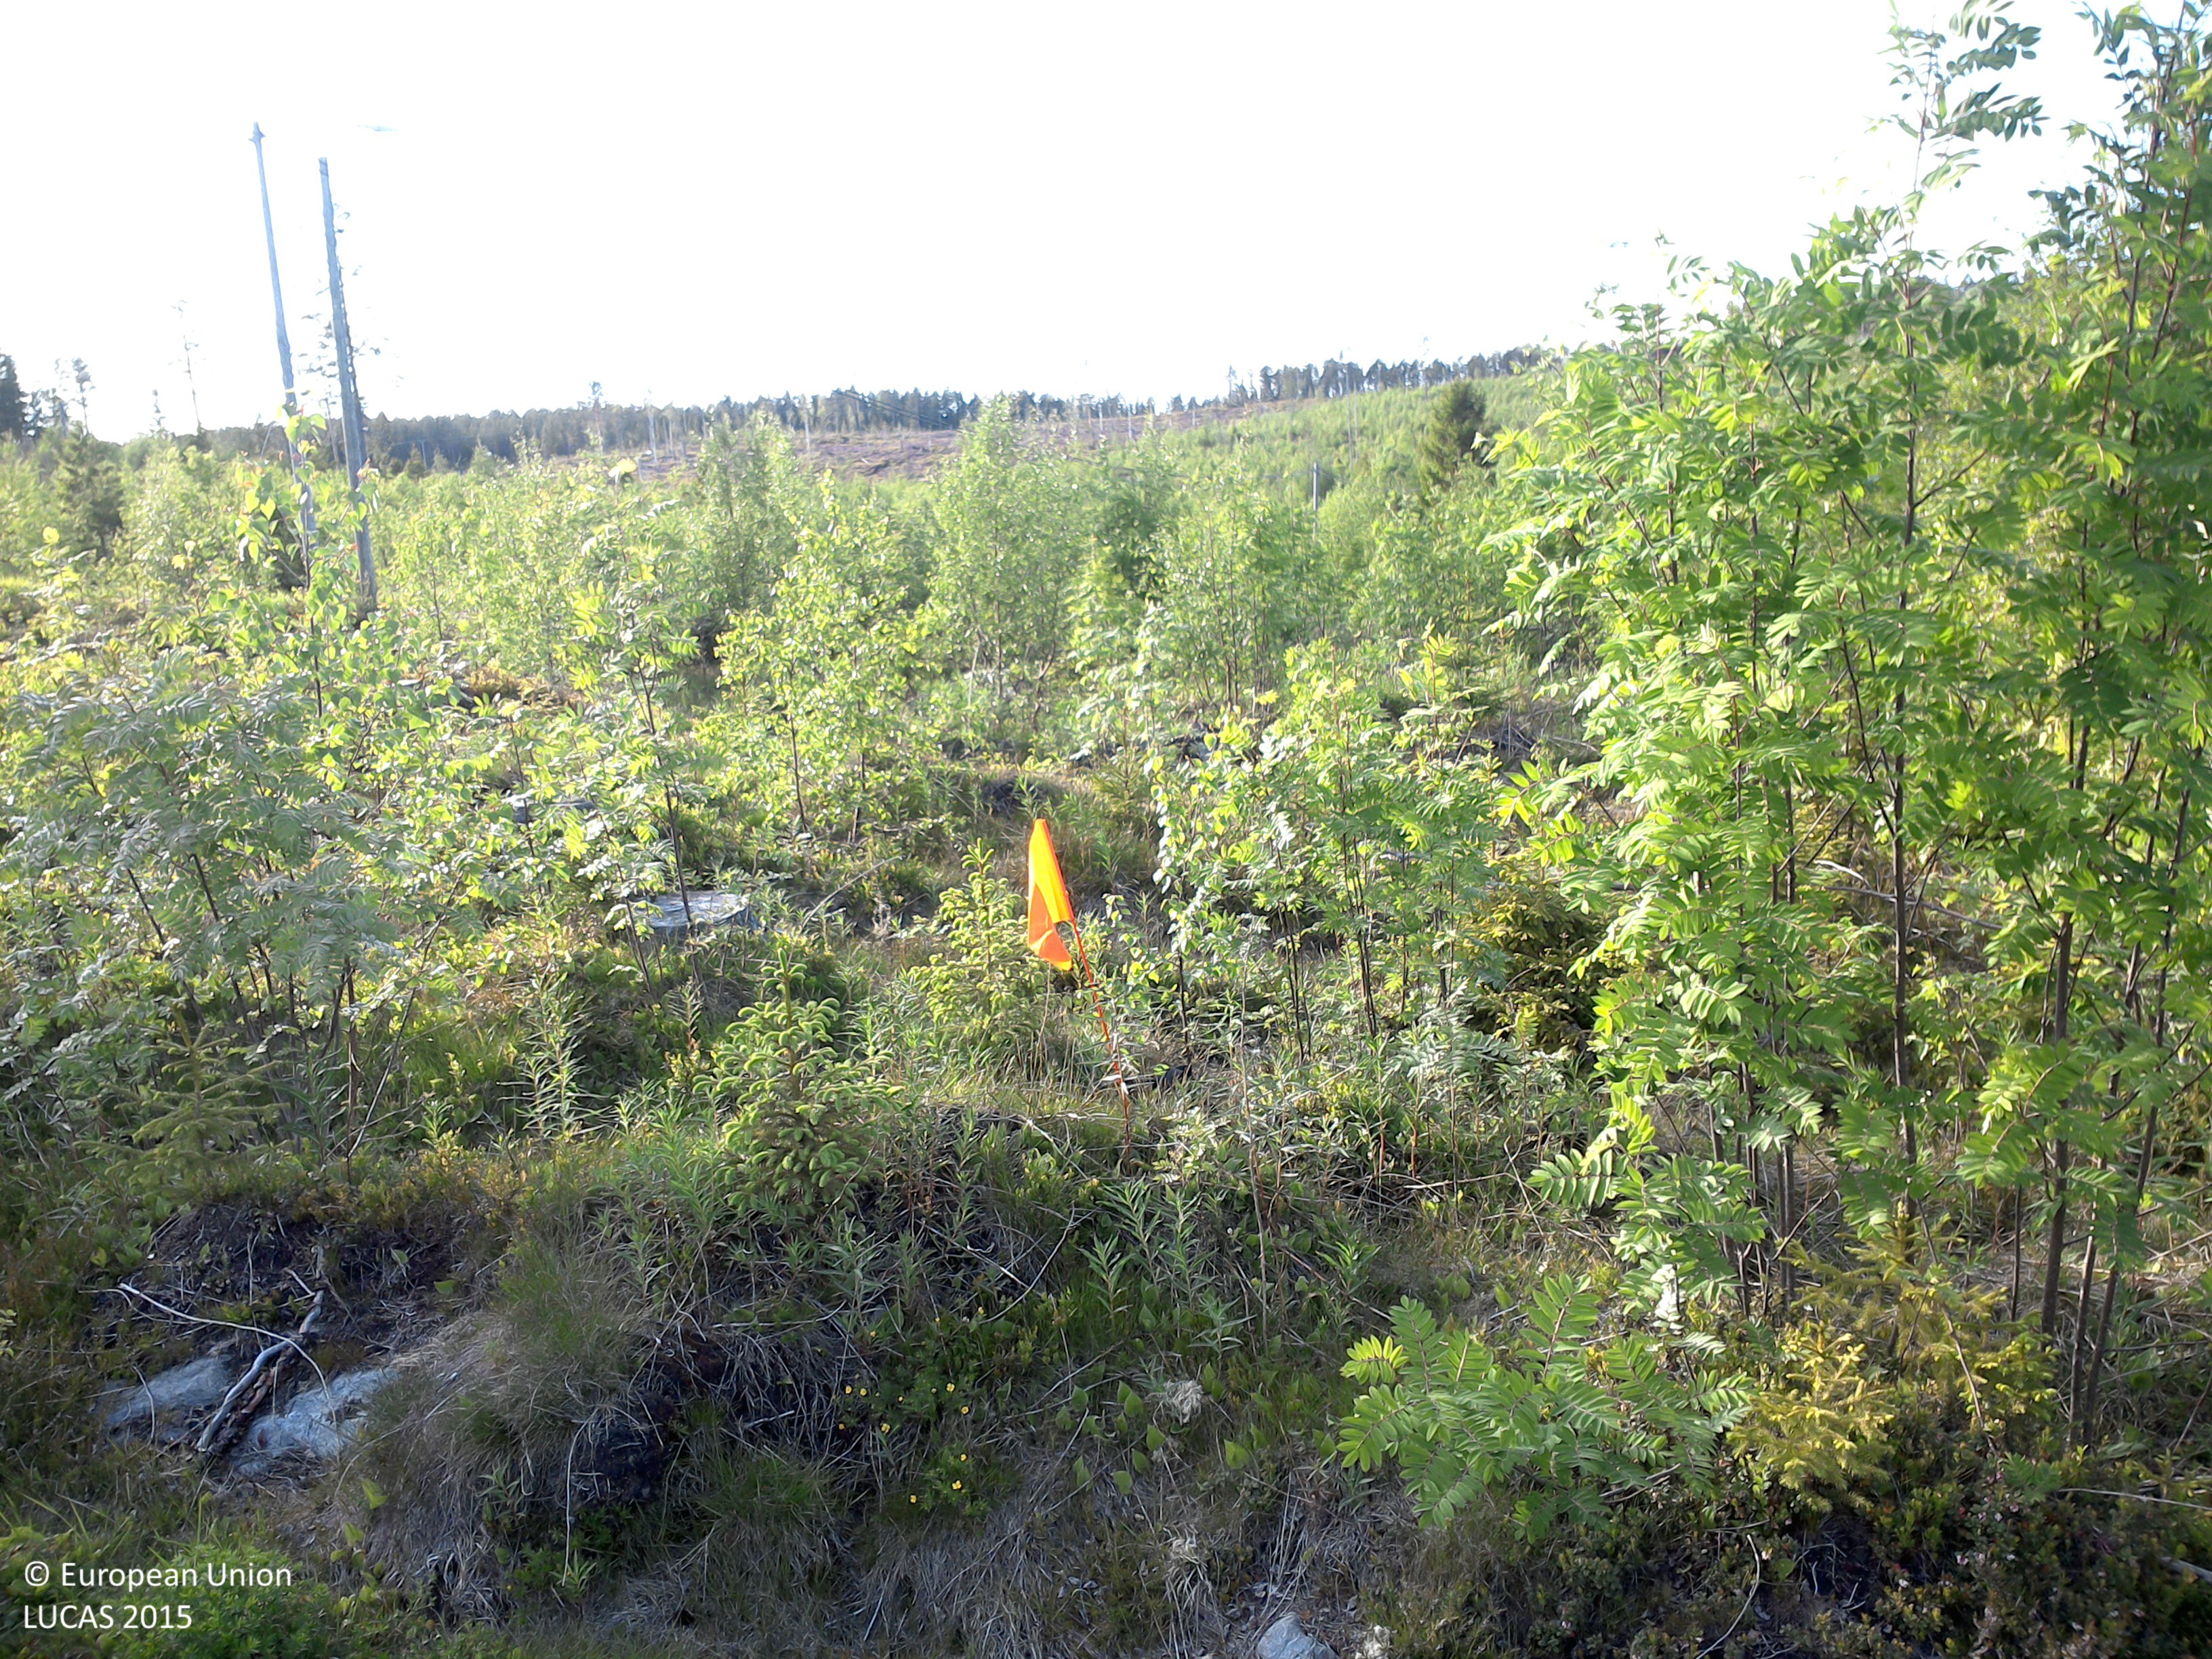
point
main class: Woodland
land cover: Broadleaved woodland
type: boreal forest
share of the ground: 10 - 25 %
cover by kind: herbaceous plants 85 %, broadleaved forest trees 15 %
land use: Forestry
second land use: Sport
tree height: < 5 m
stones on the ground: < 10 %
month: June
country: SE
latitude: 62.6416
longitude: 17.8797
